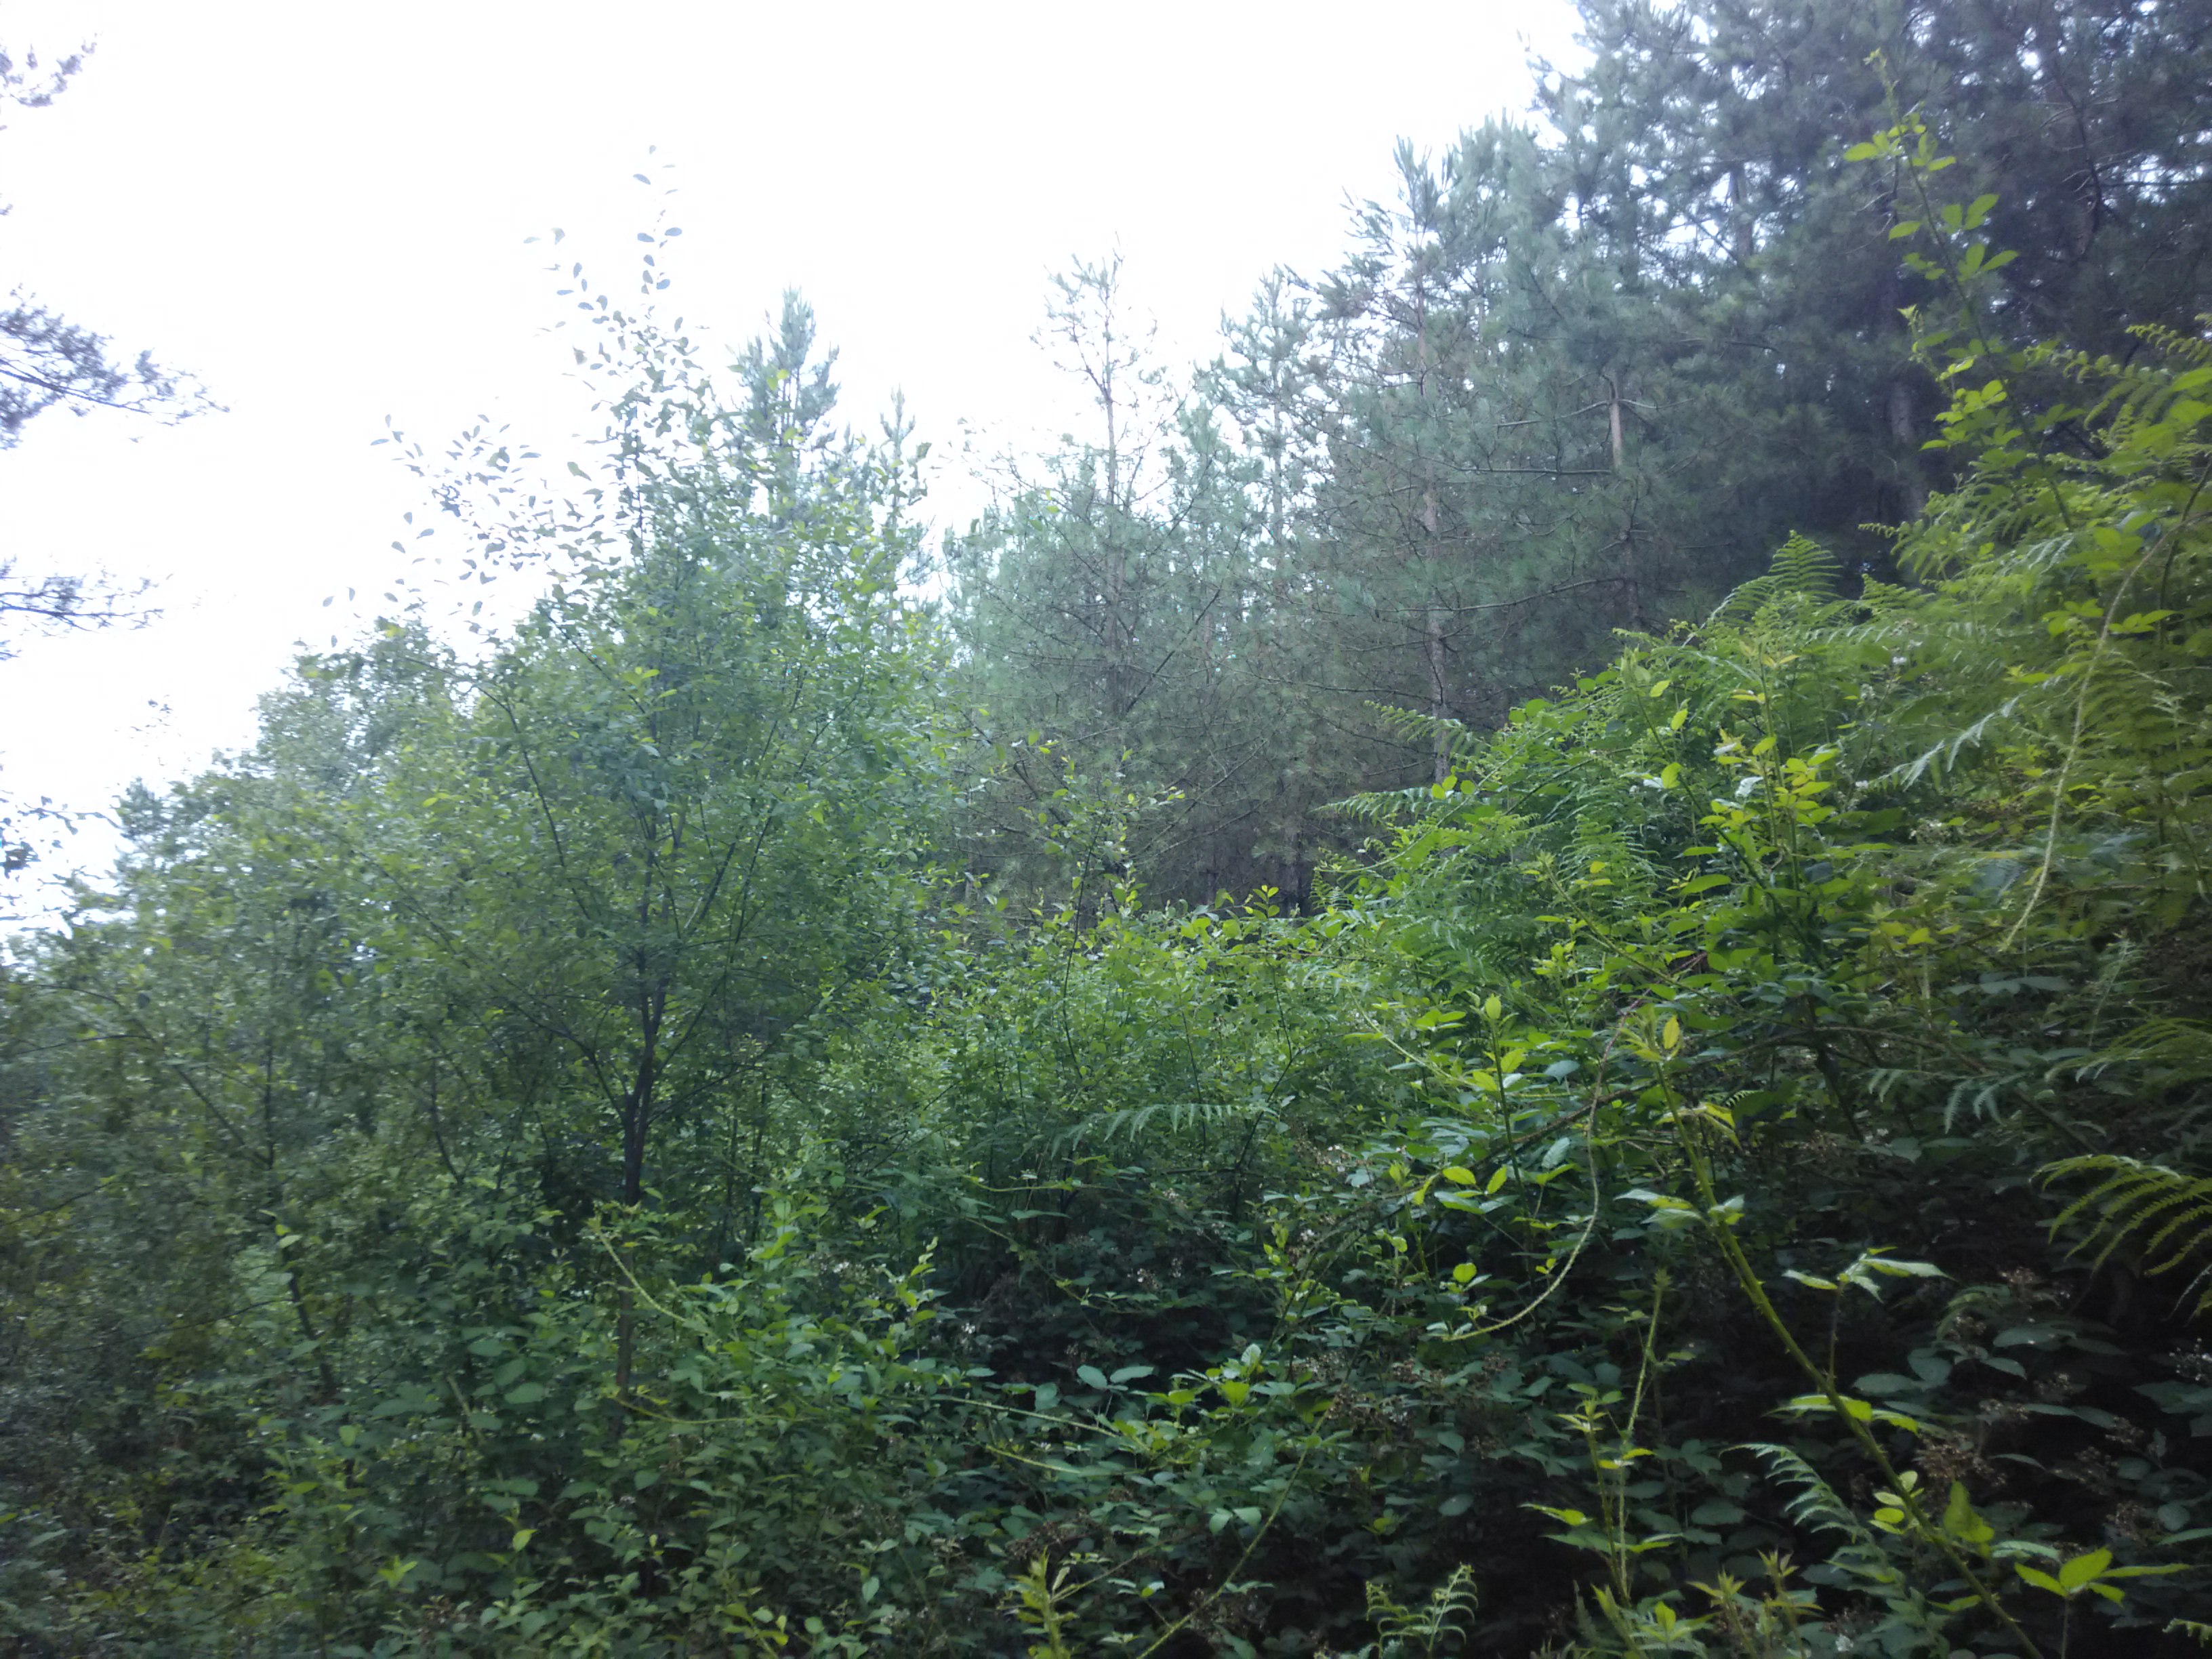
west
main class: Woodland
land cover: Pine dominated coniferous woodland
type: exotic forest
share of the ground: > 75 %
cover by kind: coniferous forest trees 80 %, shrubs 15 %, unconsolidated bare surface 5 %
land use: Forestry
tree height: > 5 m
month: July
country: ES
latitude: 43.1023
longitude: -2.4735
